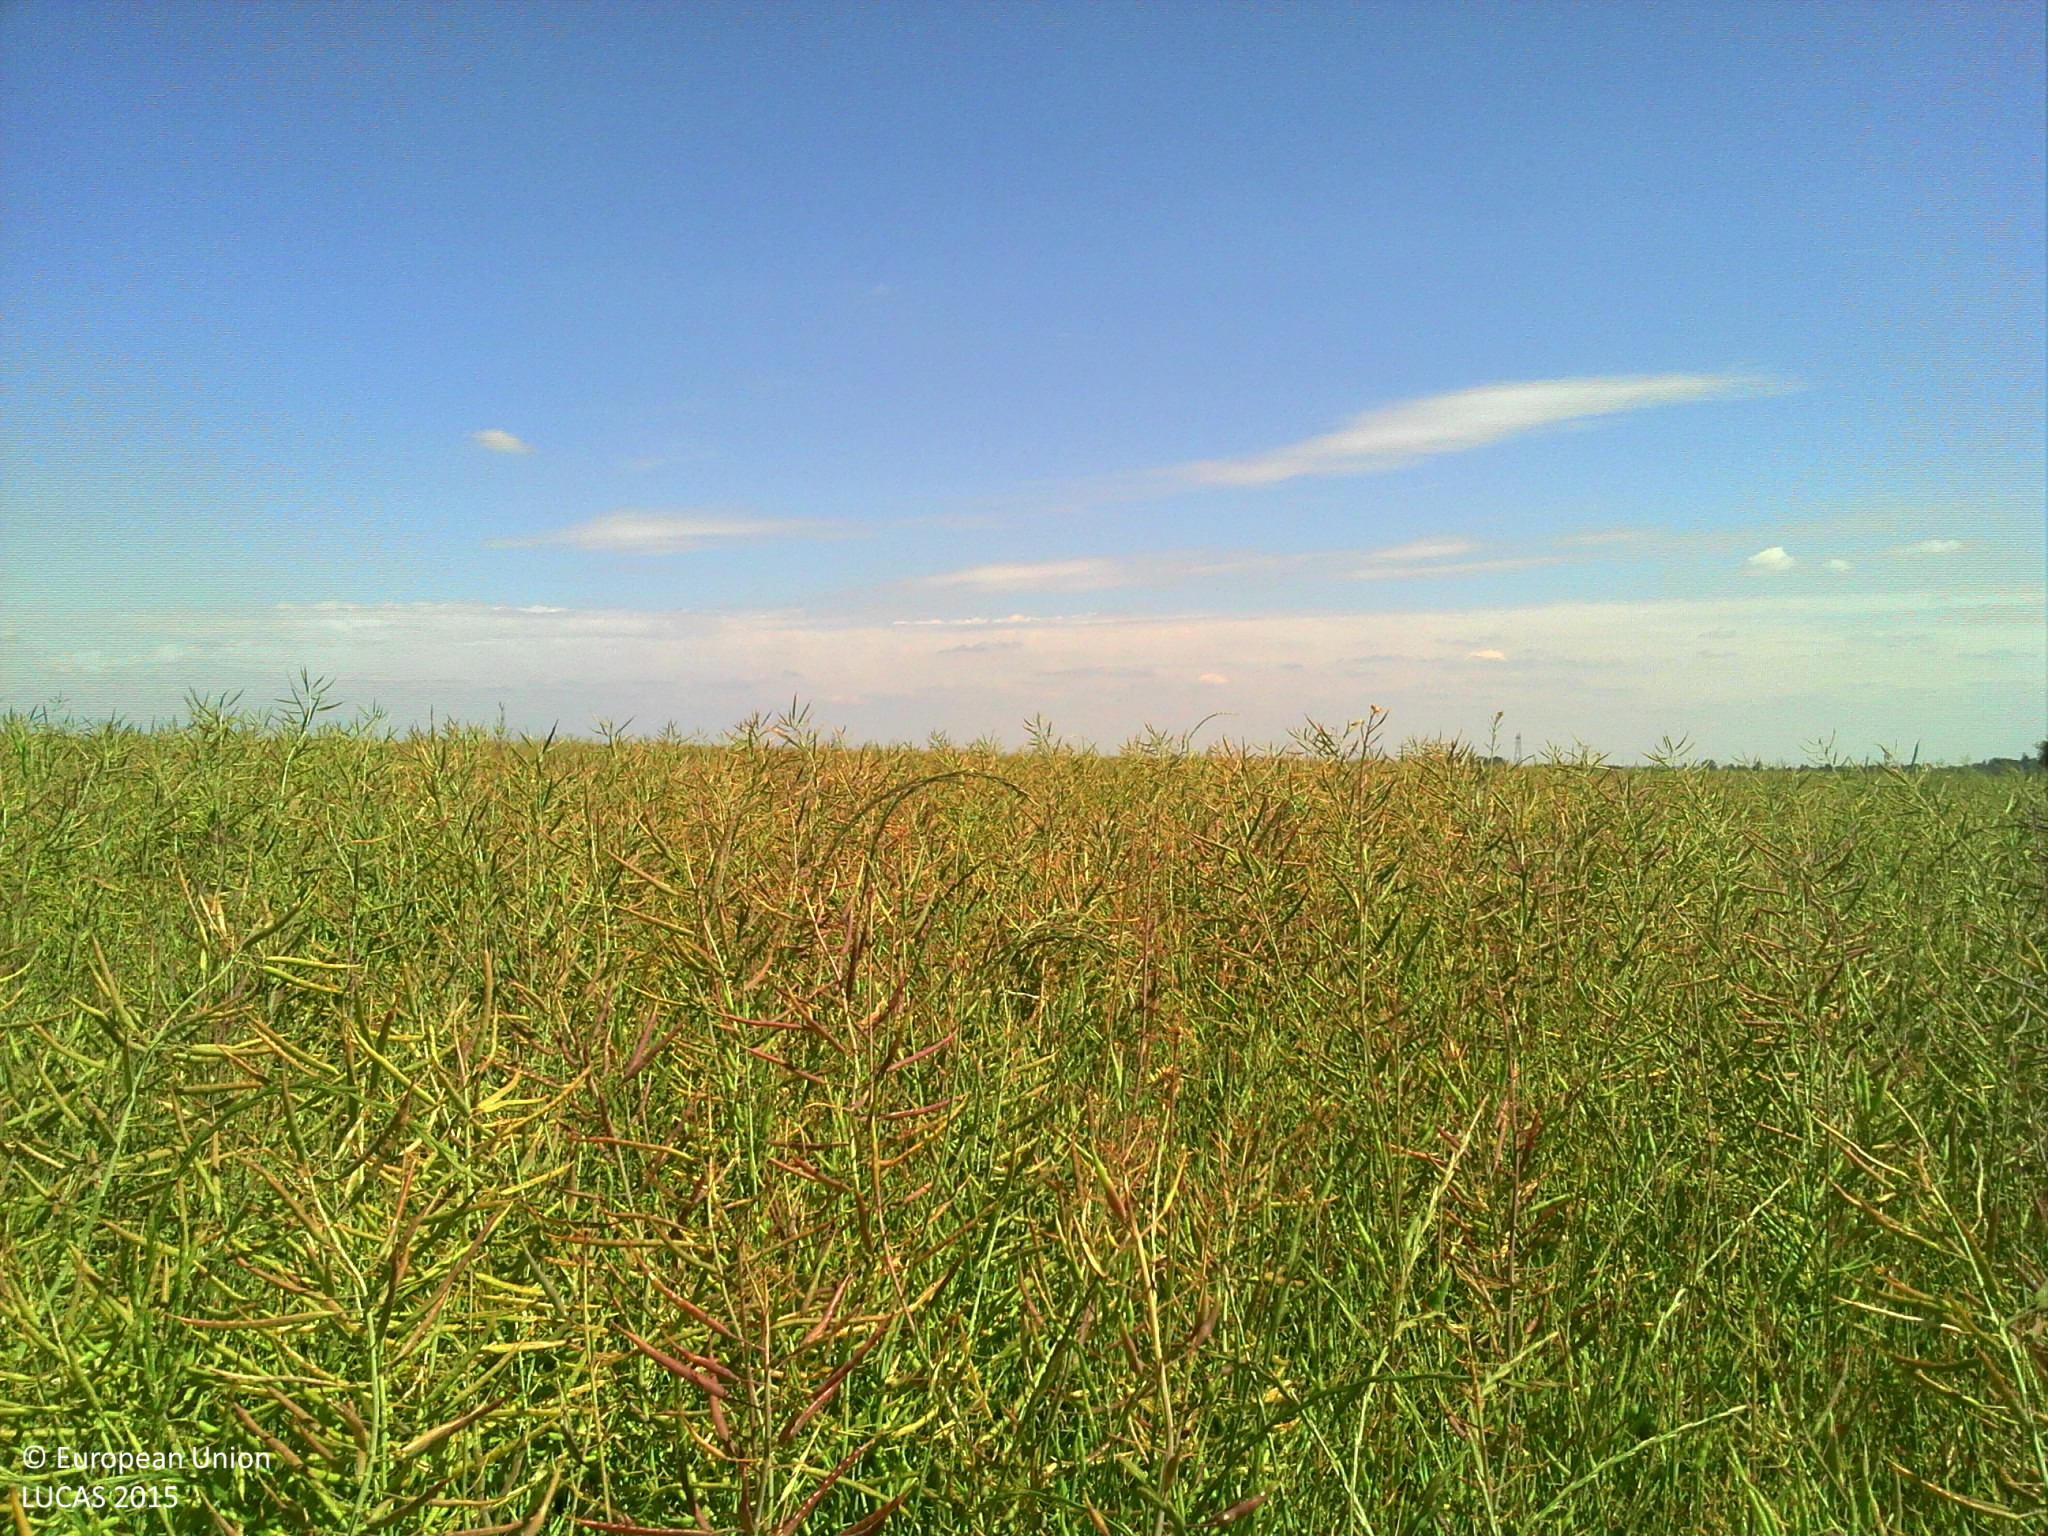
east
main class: Cropland
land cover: Rape and turnip rape
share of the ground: > 75 %
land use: Agriculture (excluding fallow land and kitchen gardens)
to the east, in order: Rape and turnip rape; Grass margins; Common wheat
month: June
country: FR
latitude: 49.5065
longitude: 2.5447
